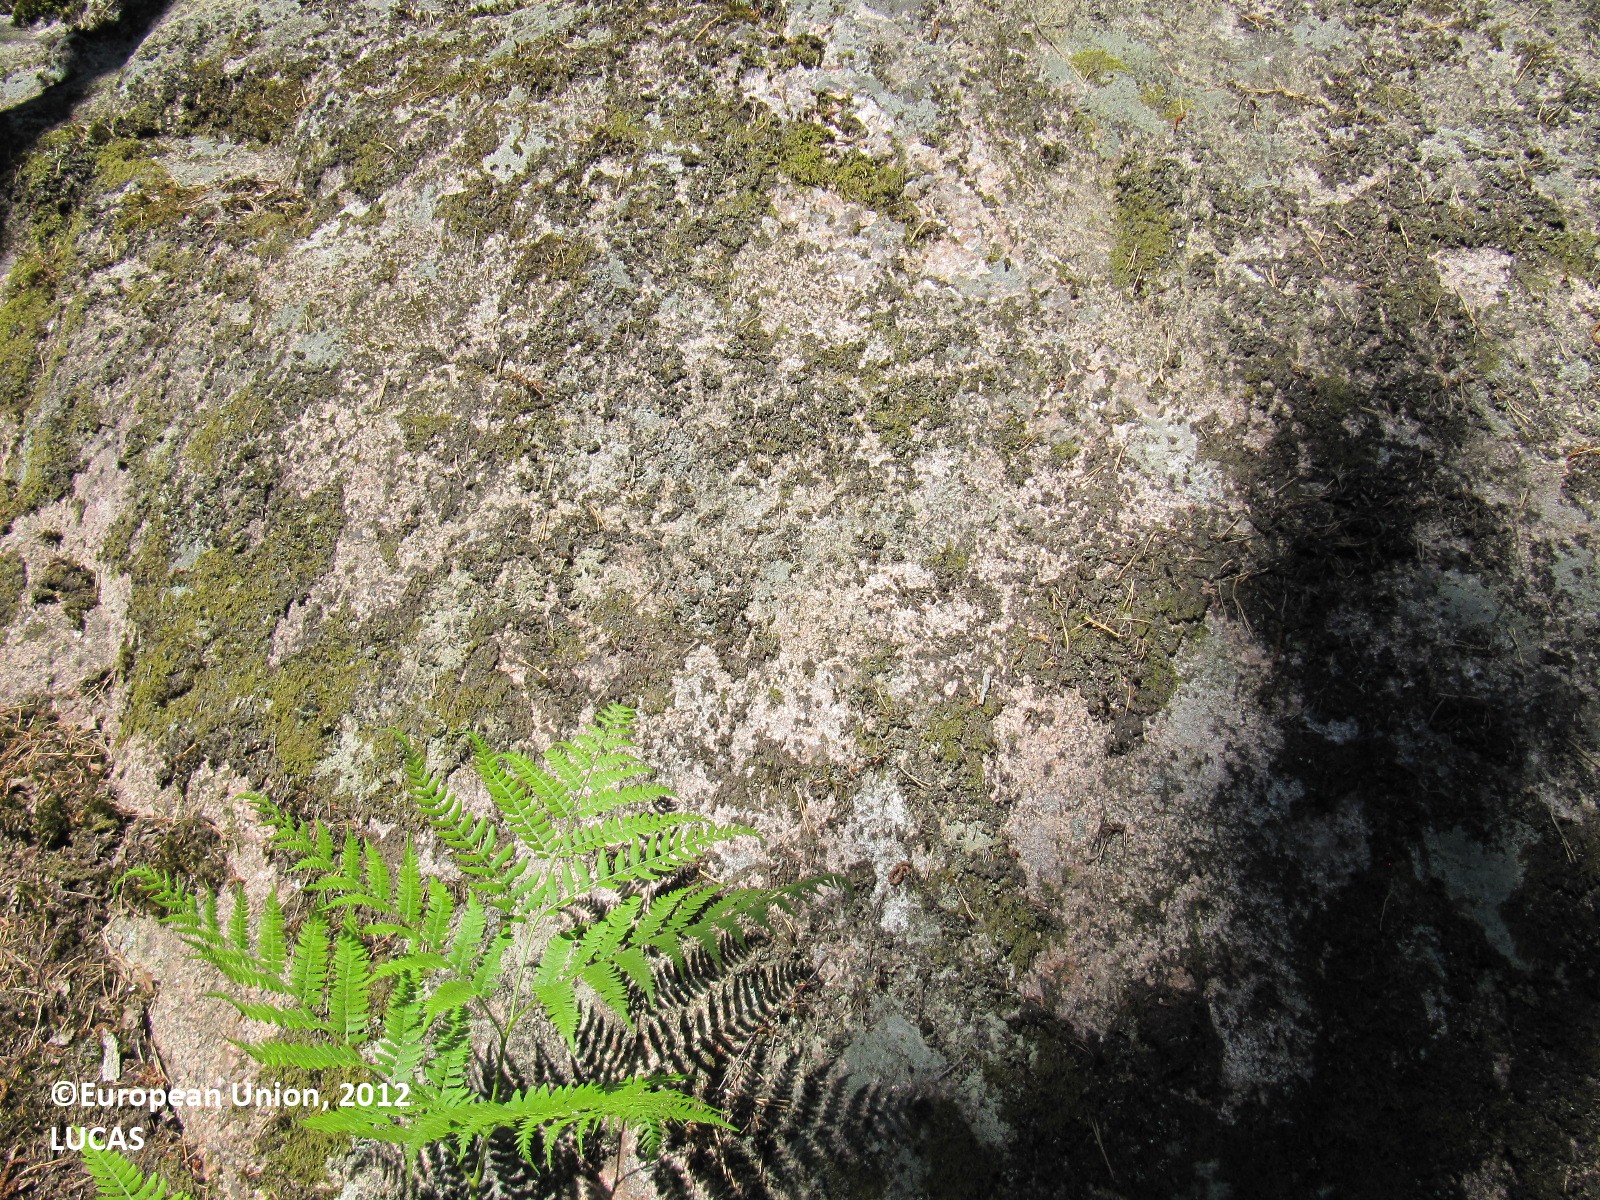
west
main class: Woodland
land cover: Pine dominated mixed woodland
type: boreal forest
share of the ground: 25 - 50 %
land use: Forestry
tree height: > 5 m
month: June
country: FI
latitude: 60.1495
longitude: 24.2424
